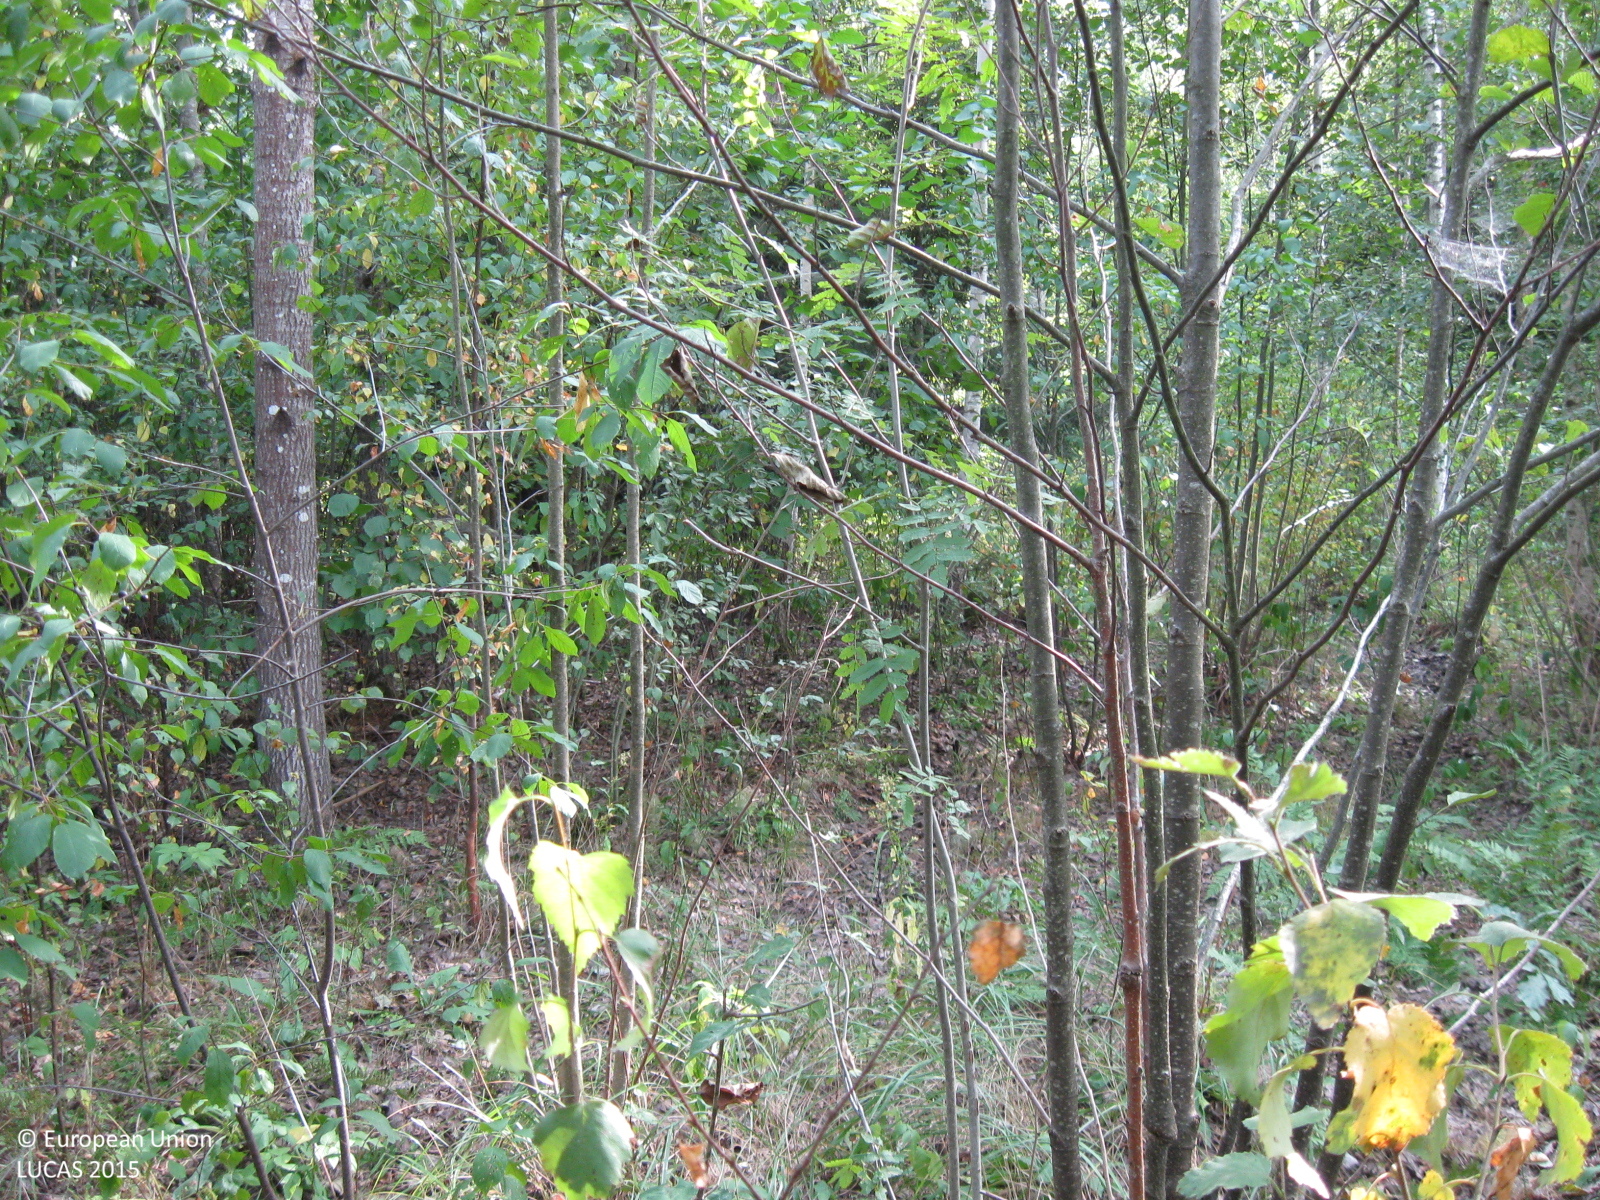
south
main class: Woodland
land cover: Broadleaved woodland
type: non-riverine alder, birch or aspen forest
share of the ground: > 75 %
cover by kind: broadleaved forest trees 85 %, coniferous forest trees 10 %, herbaceous plants 5 %
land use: Forestry
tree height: > 5 m
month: August
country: LT
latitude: 55.2604
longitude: 22.8927
